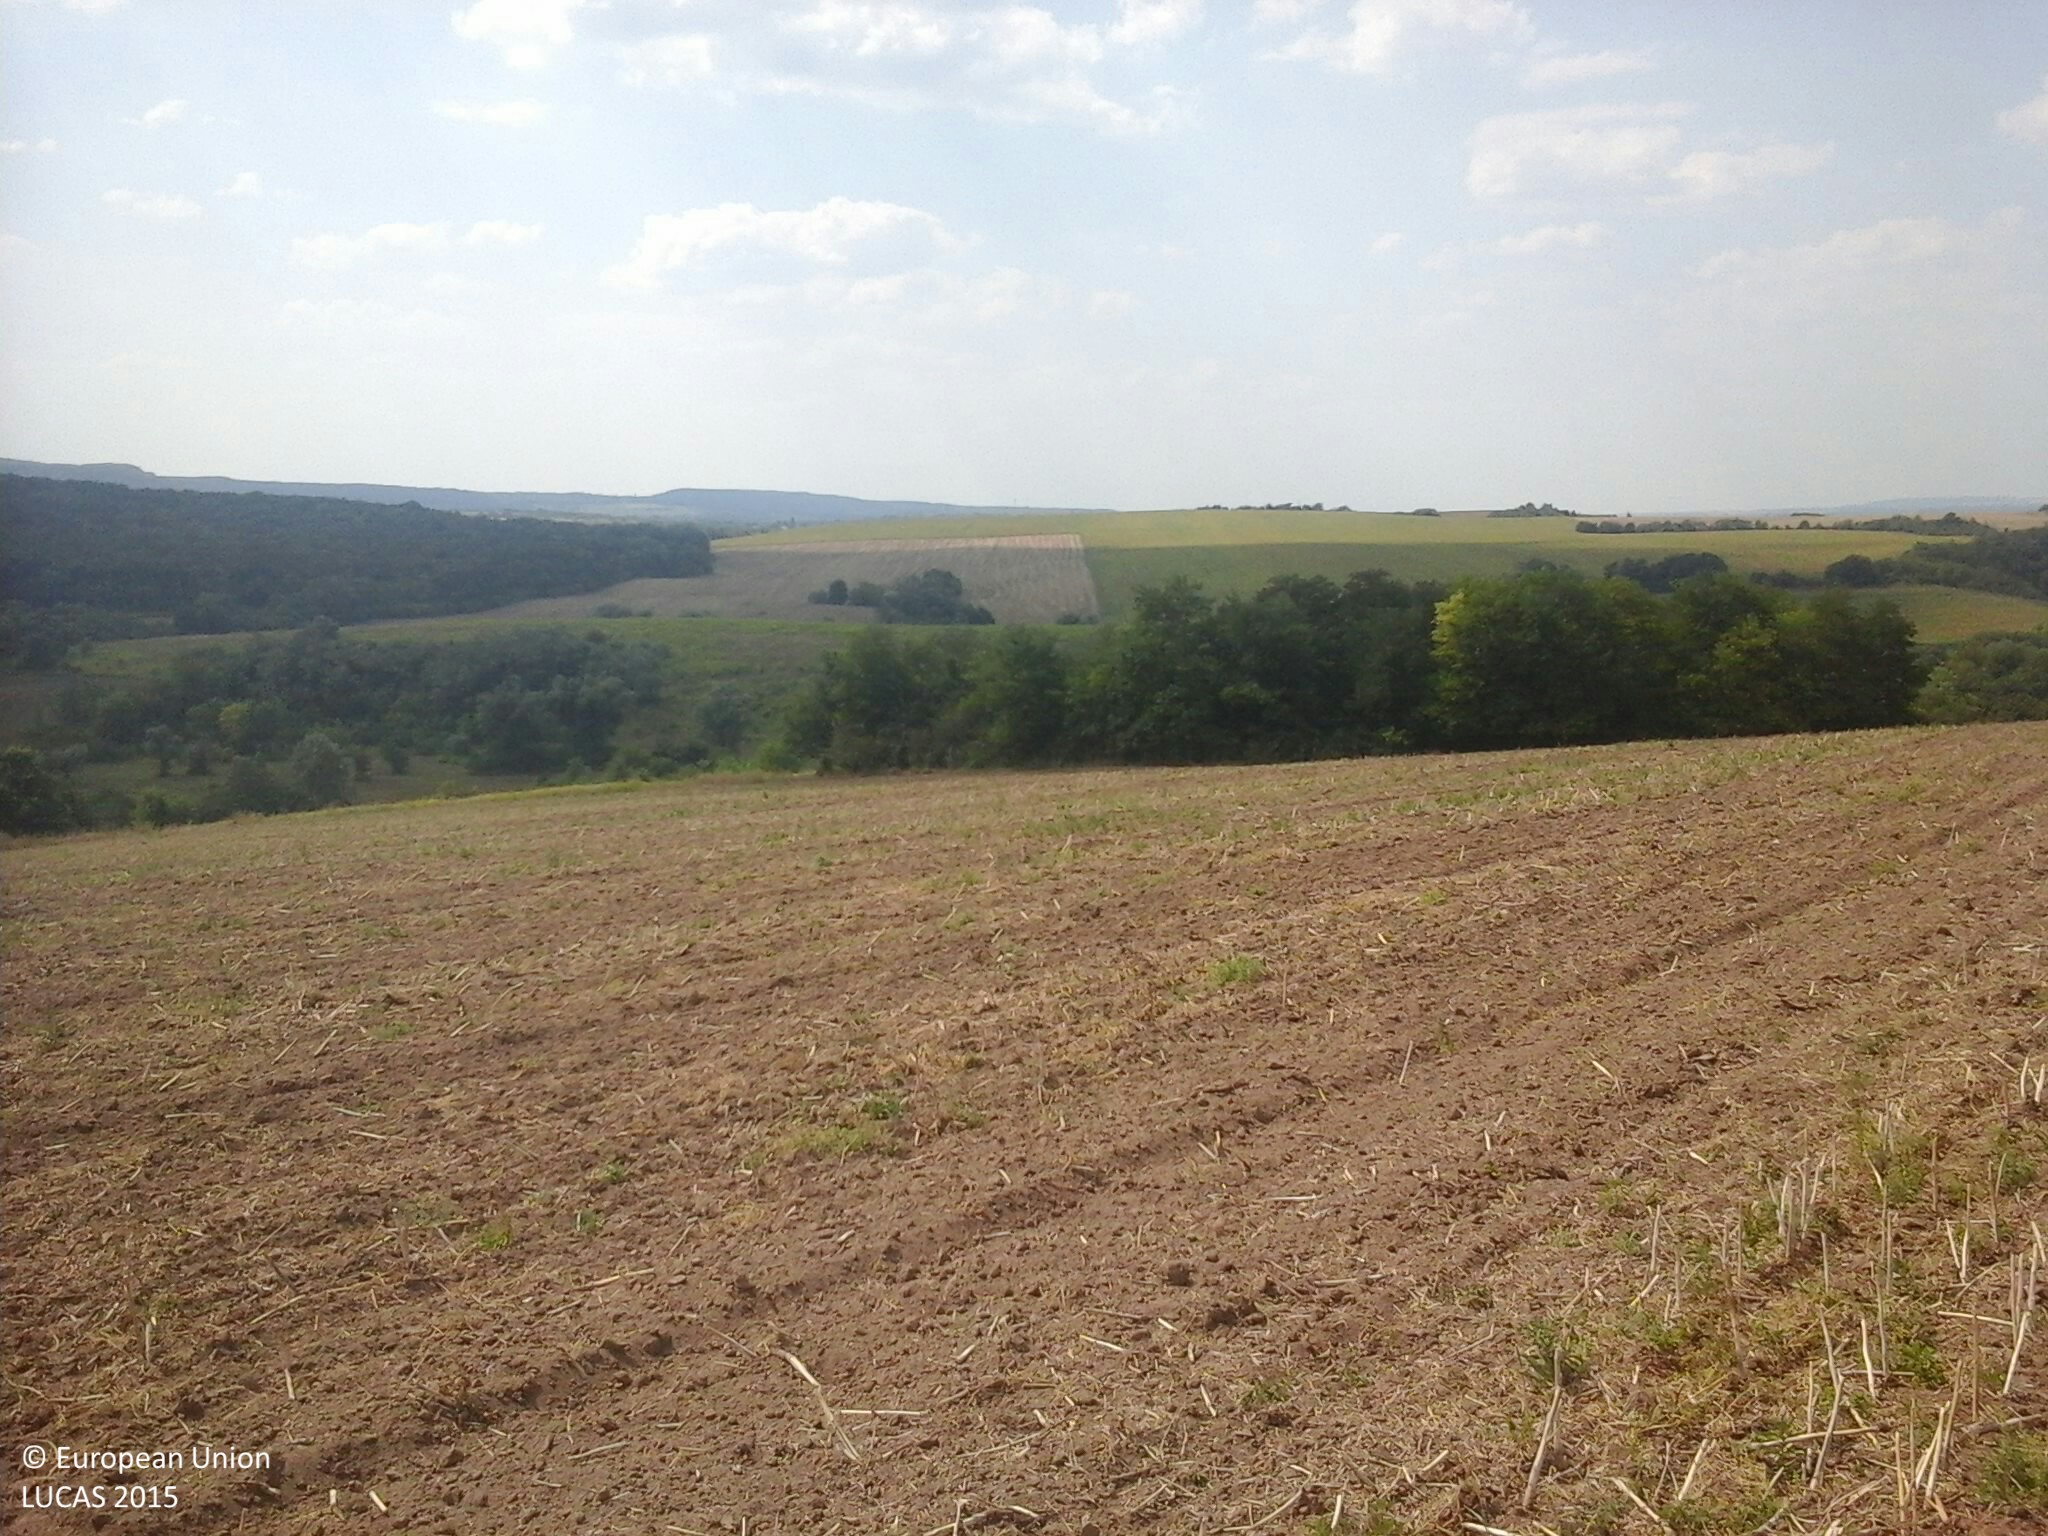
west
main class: Cropland
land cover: Rape and turnip rape
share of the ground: < 10 %
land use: Agriculture (excluding fallow land and kitchen gardens)
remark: Harvested field
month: August
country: HU
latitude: 47.7430
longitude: 18.5908
